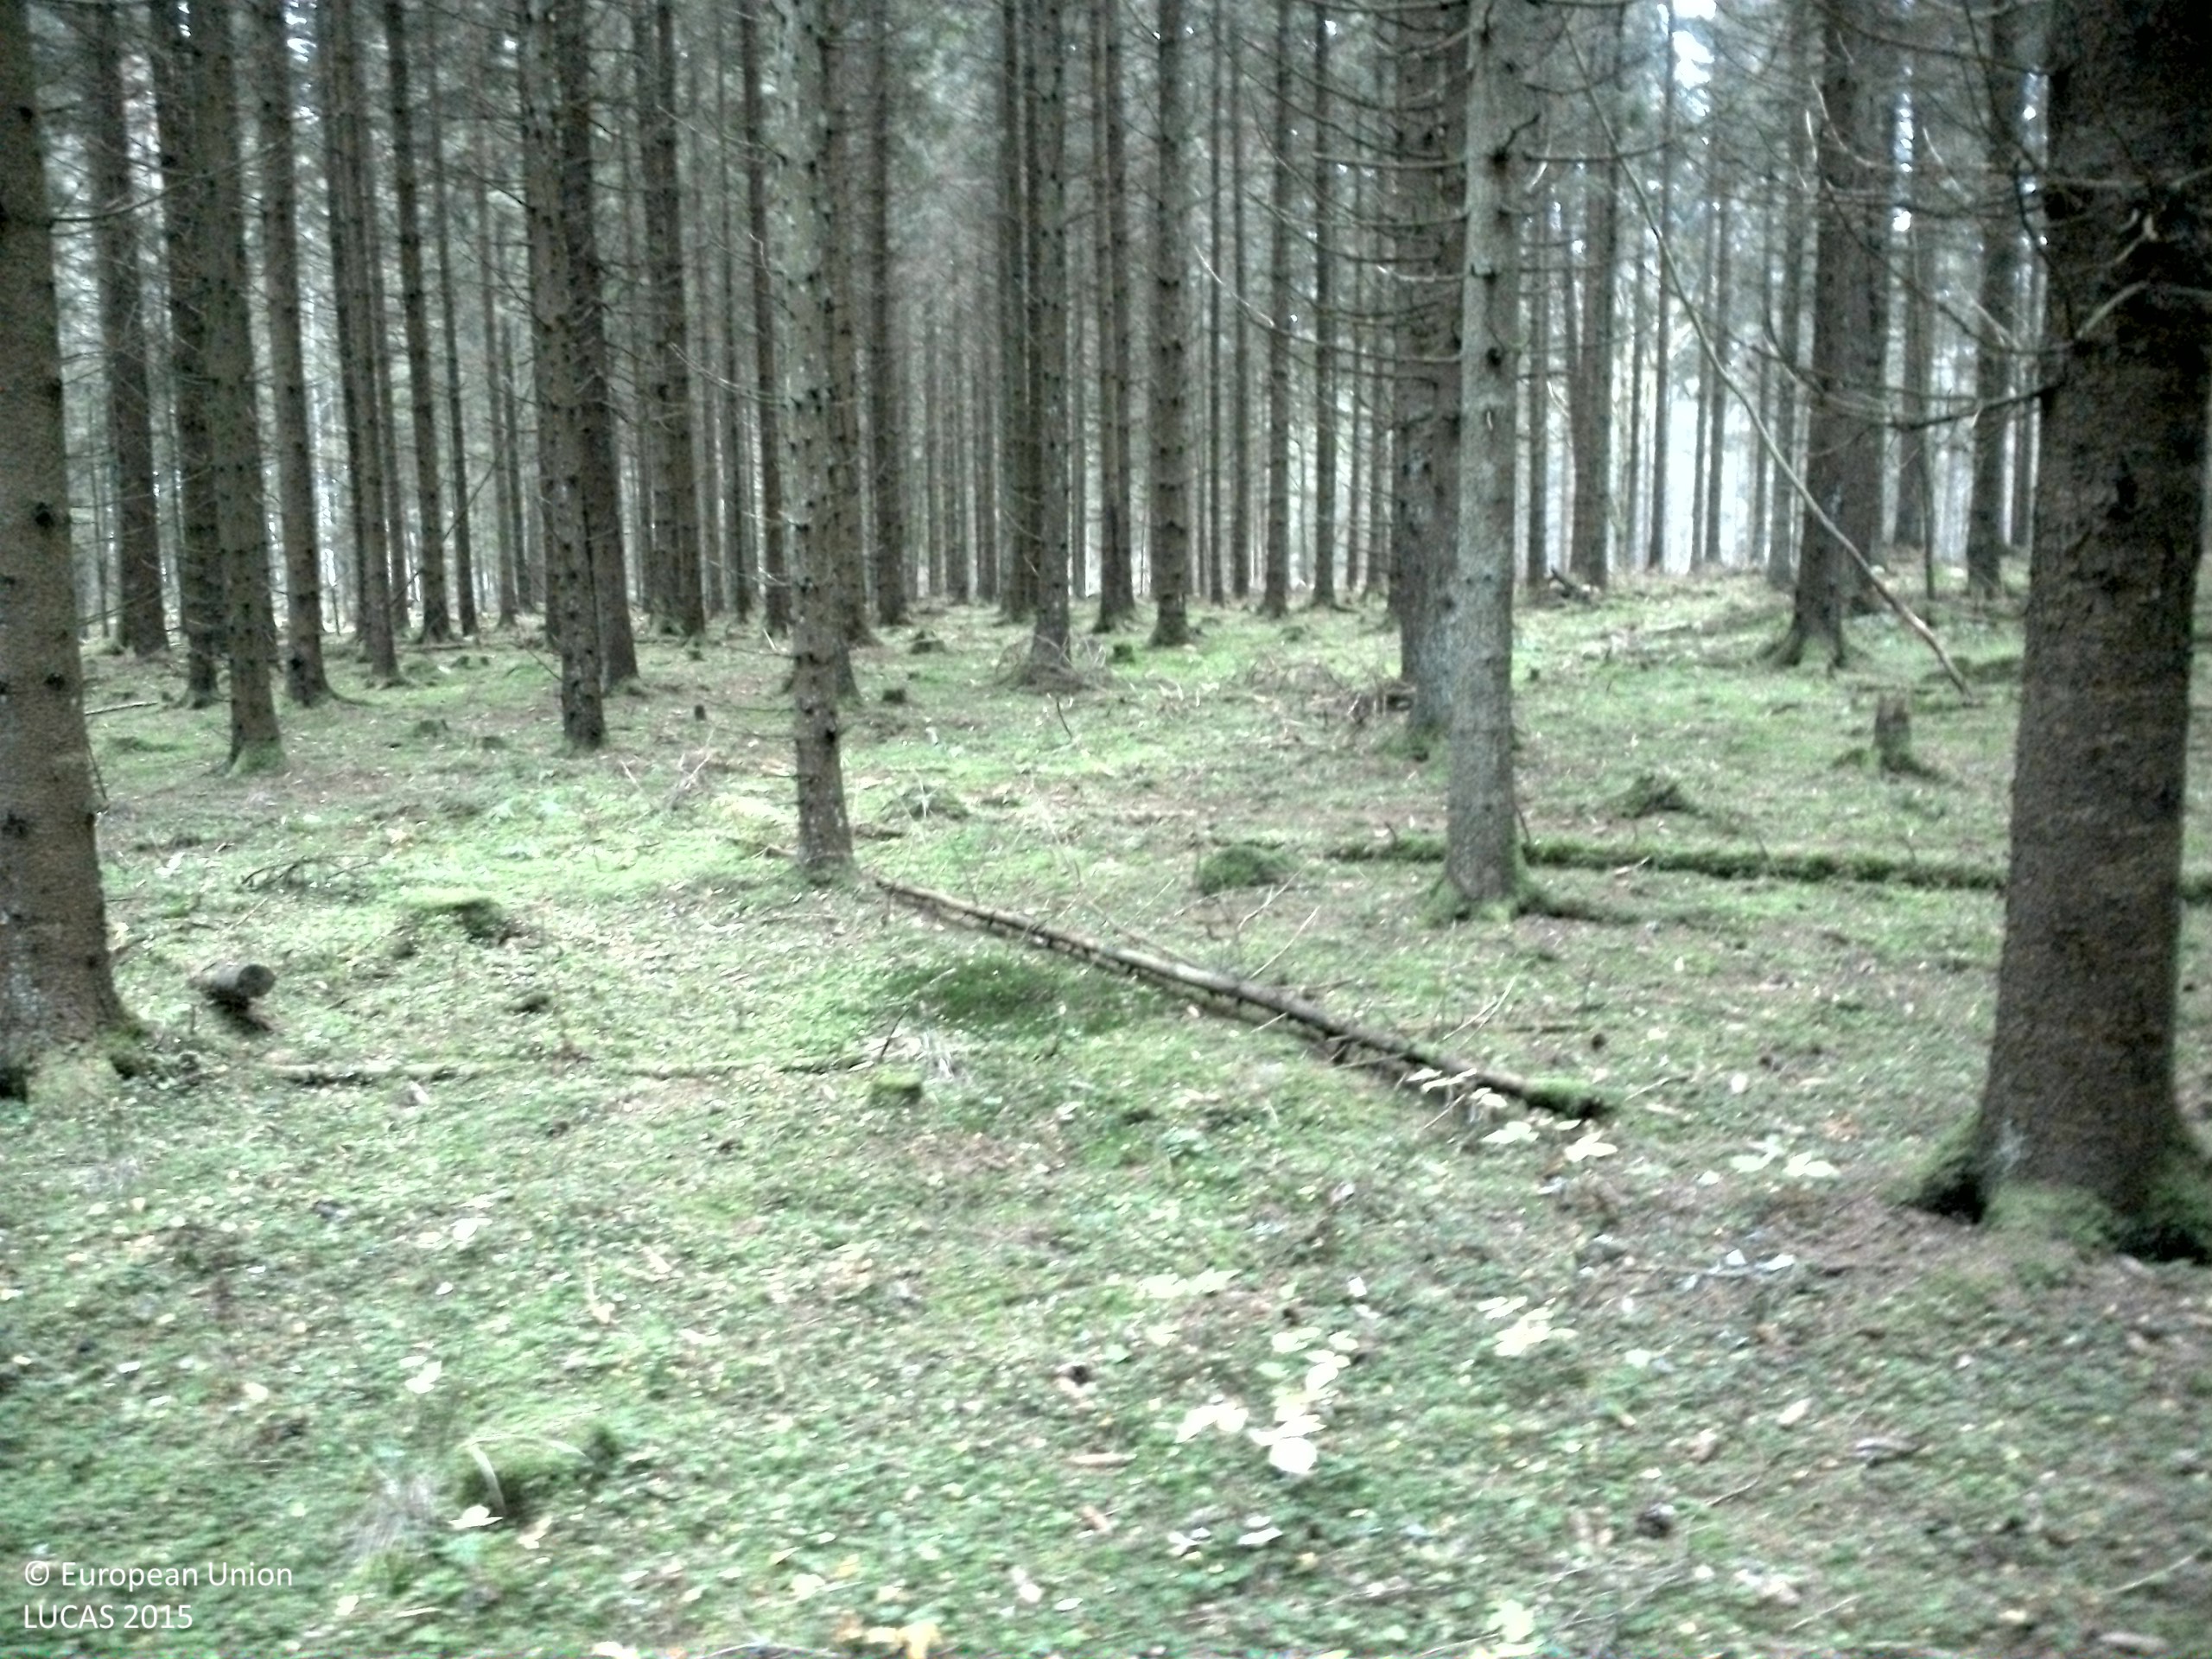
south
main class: Woodland
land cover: Spruce dominated coniferous woodland
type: boreal forest
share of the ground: > 75 %
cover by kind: coniferous forest trees 75 %, lichens and mosses 20 %, shrubs 5 %
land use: Forestry
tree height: > 5 m
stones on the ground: < 10 %
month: November
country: SE
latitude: 57.8394
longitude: 14.4586
